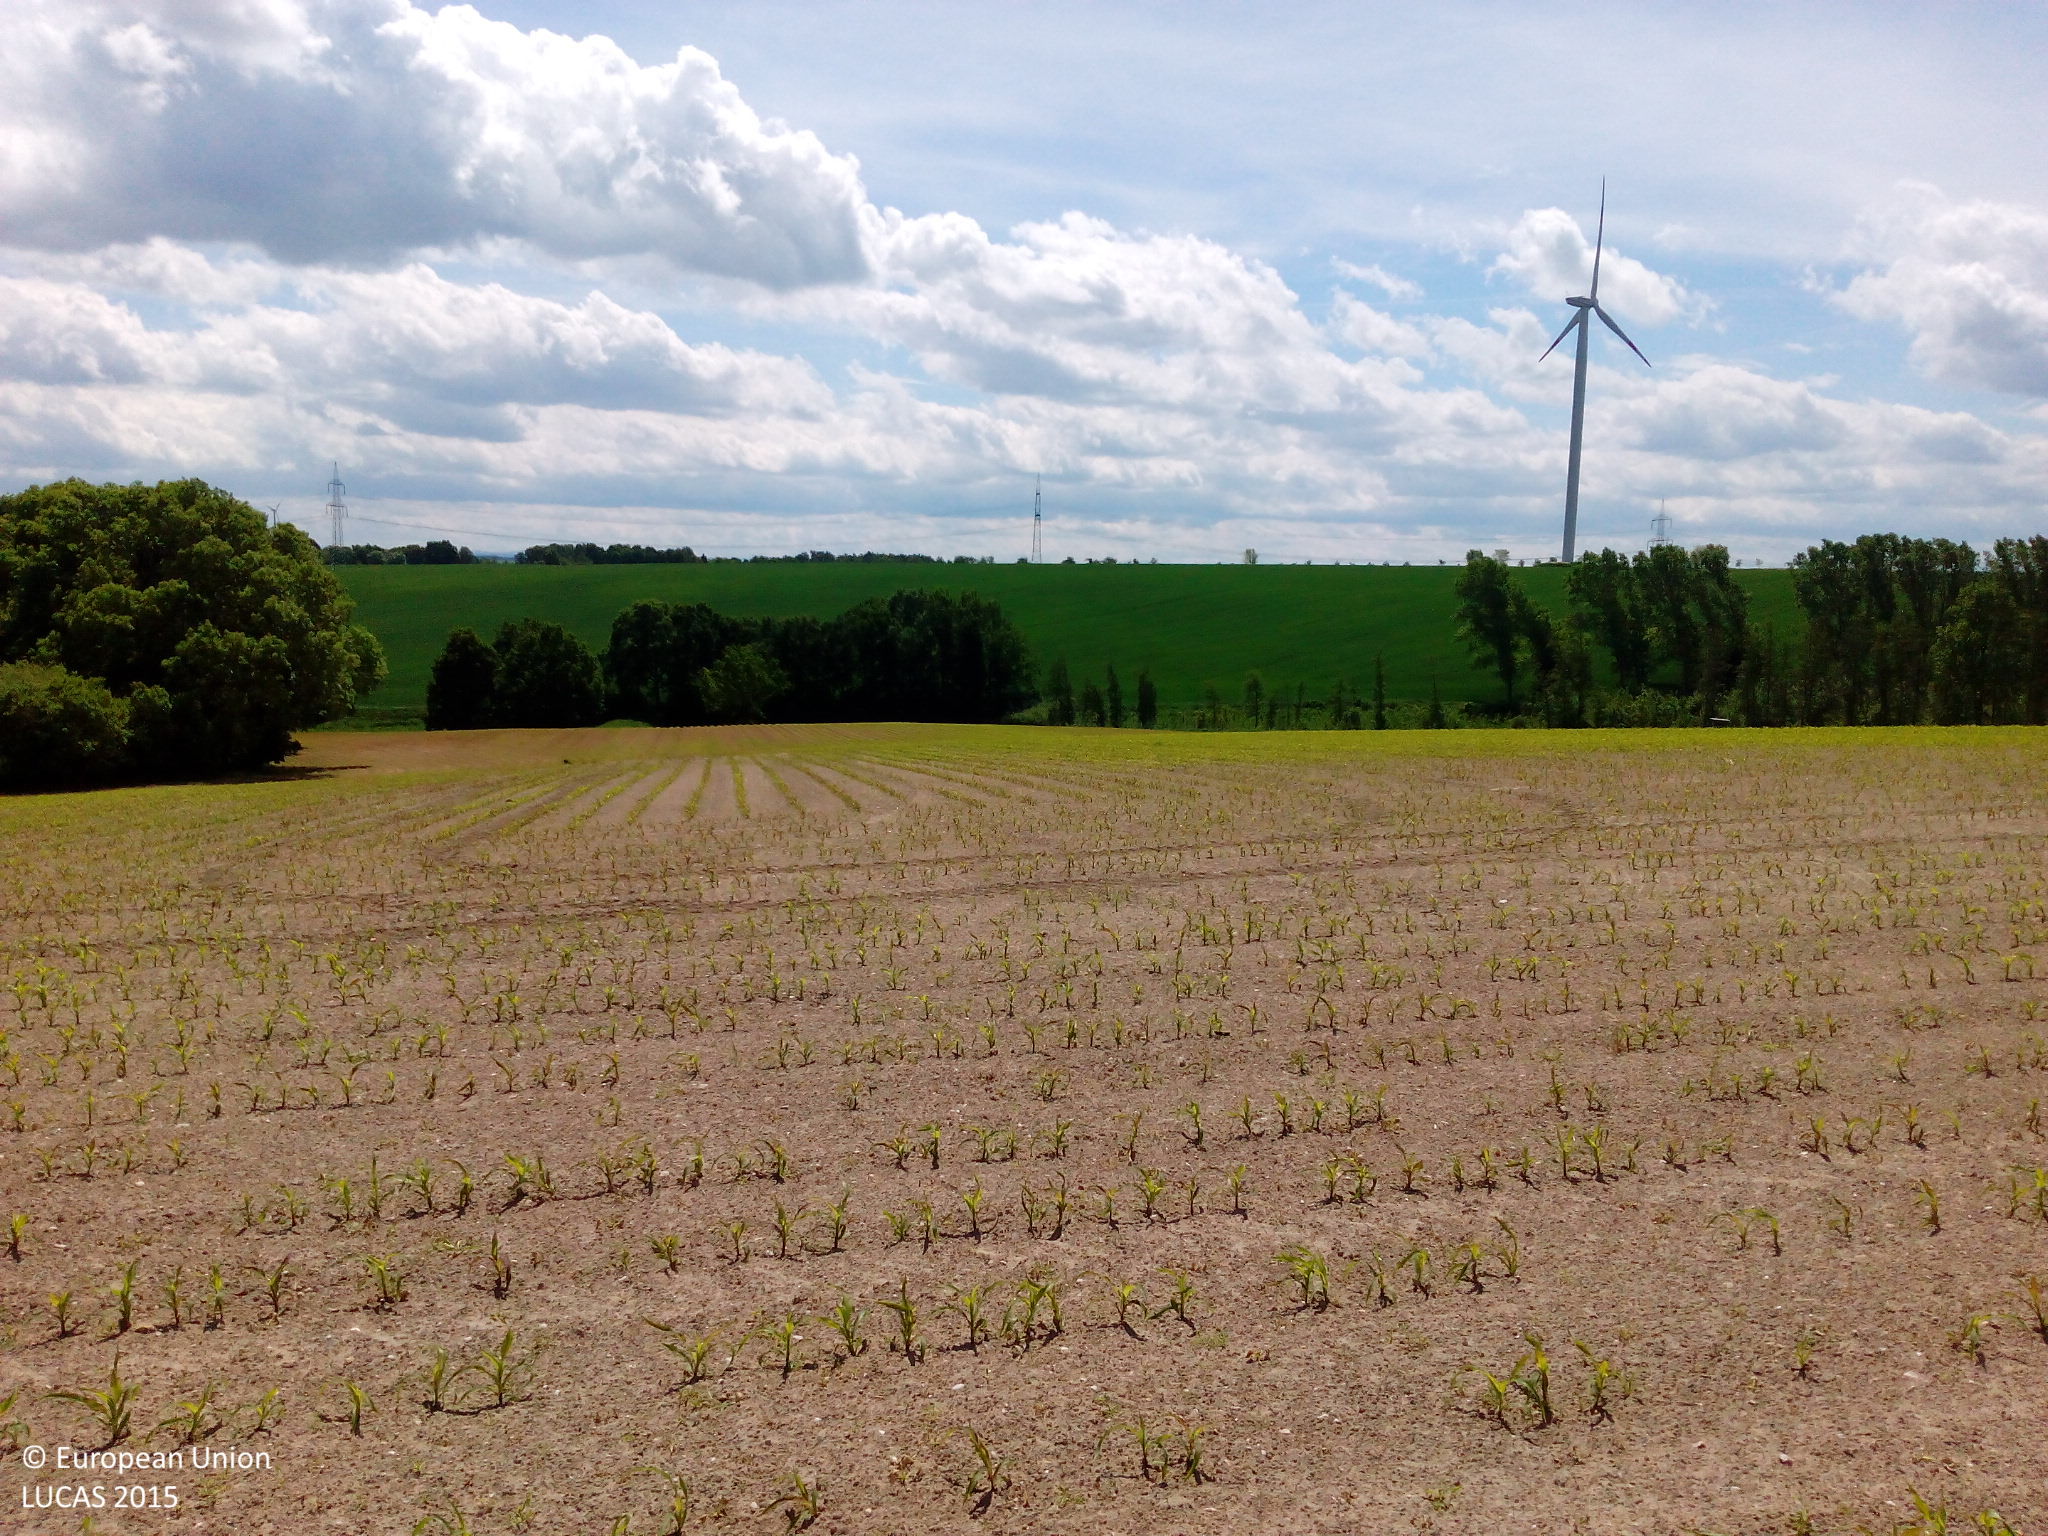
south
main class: Cropland
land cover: Barley
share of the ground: > 75 %
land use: Agriculture (excluding fallow land and kitchen gardens)
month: May
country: DE
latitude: 50.8785
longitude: 12.4017
